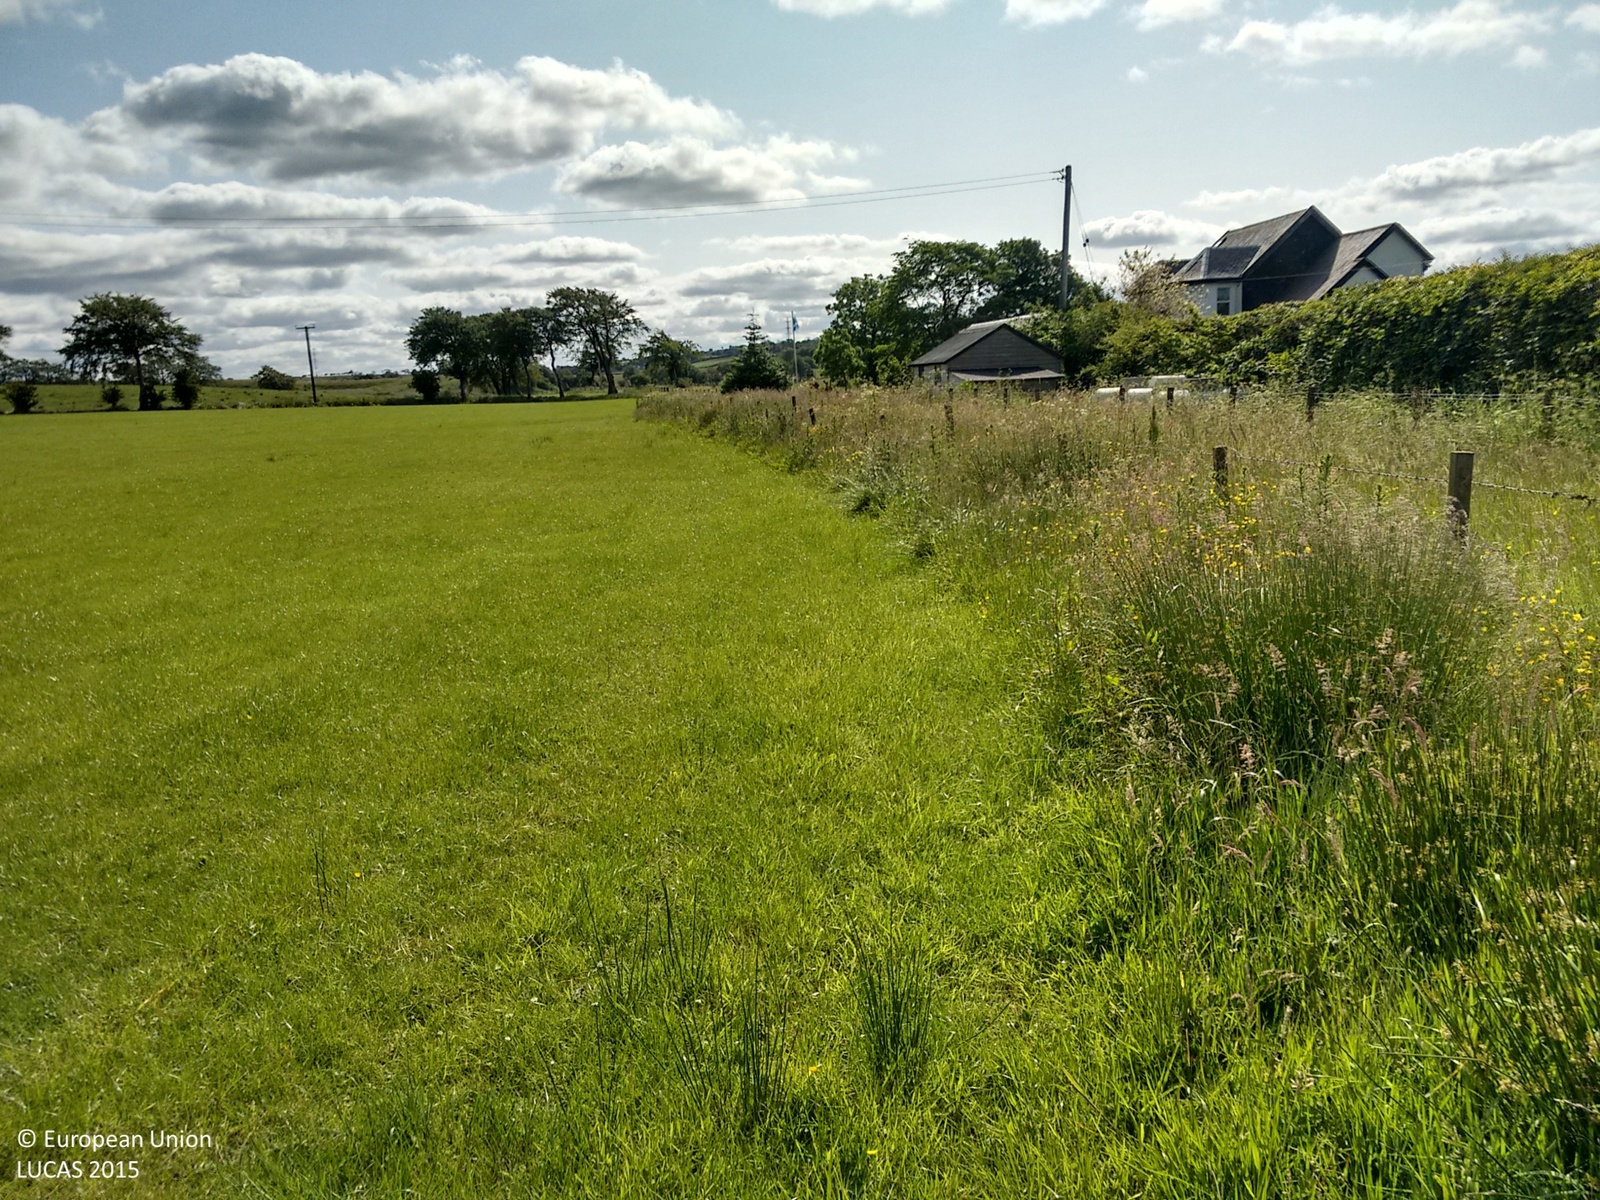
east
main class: Grassland
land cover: Grassland without tree/shrub cover
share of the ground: > 75 %
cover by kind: herbaceous plants 90 %, unconsolidated bare surface 10 %
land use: Agriculture (excluding fallow land and kitchen gardens)
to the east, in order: Grassland without tree/shrub cover; Electric lines; Grassland without tree/shrub cover; Lines of trees; Grassland without tree/shrub cover; Electric lines; Grassland without tree/shrub cover; Lines of trees; Fences; Grass margins; Fences; Grassland without tree/shrub cover
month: July
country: GB
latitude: 55.7271
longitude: -4.1512
